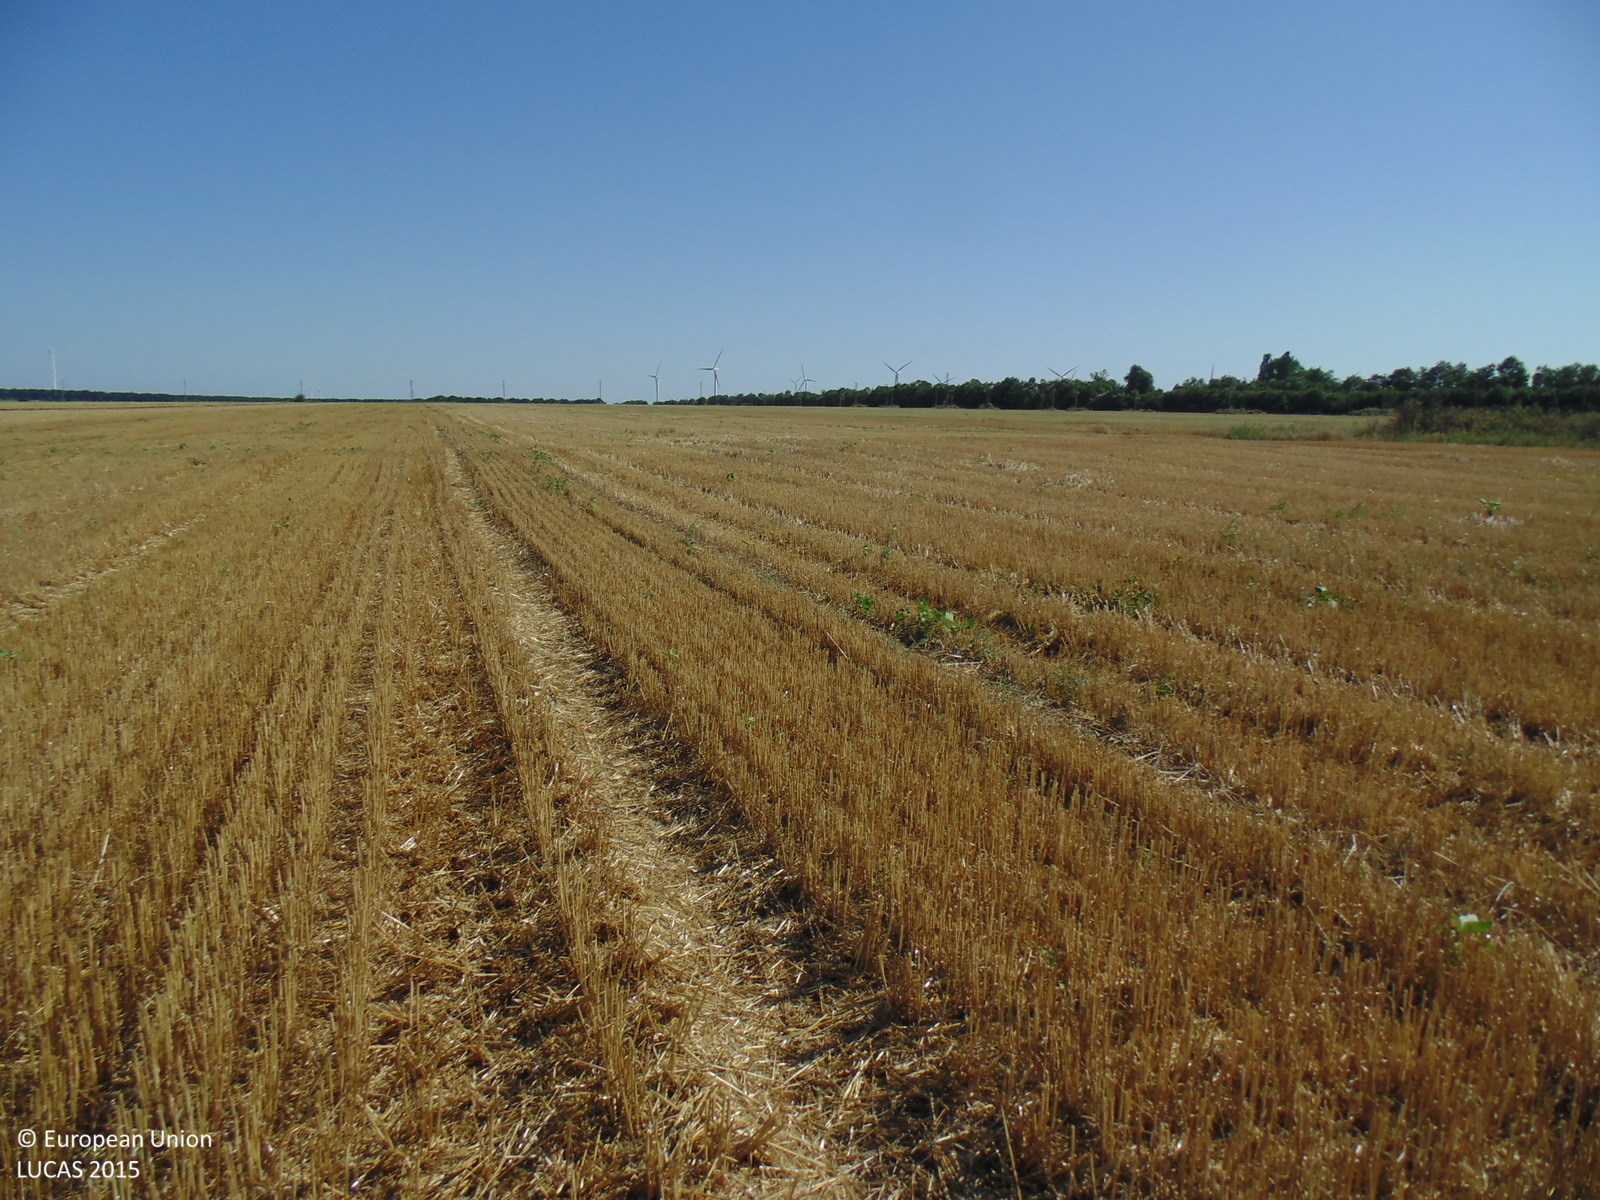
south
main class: Cropland
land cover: Common wheat
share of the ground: 50 - 75 %
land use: Agriculture (excluding fallow land and kitchen gardens)
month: August
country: BG
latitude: 43.4827
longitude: 28.2922
